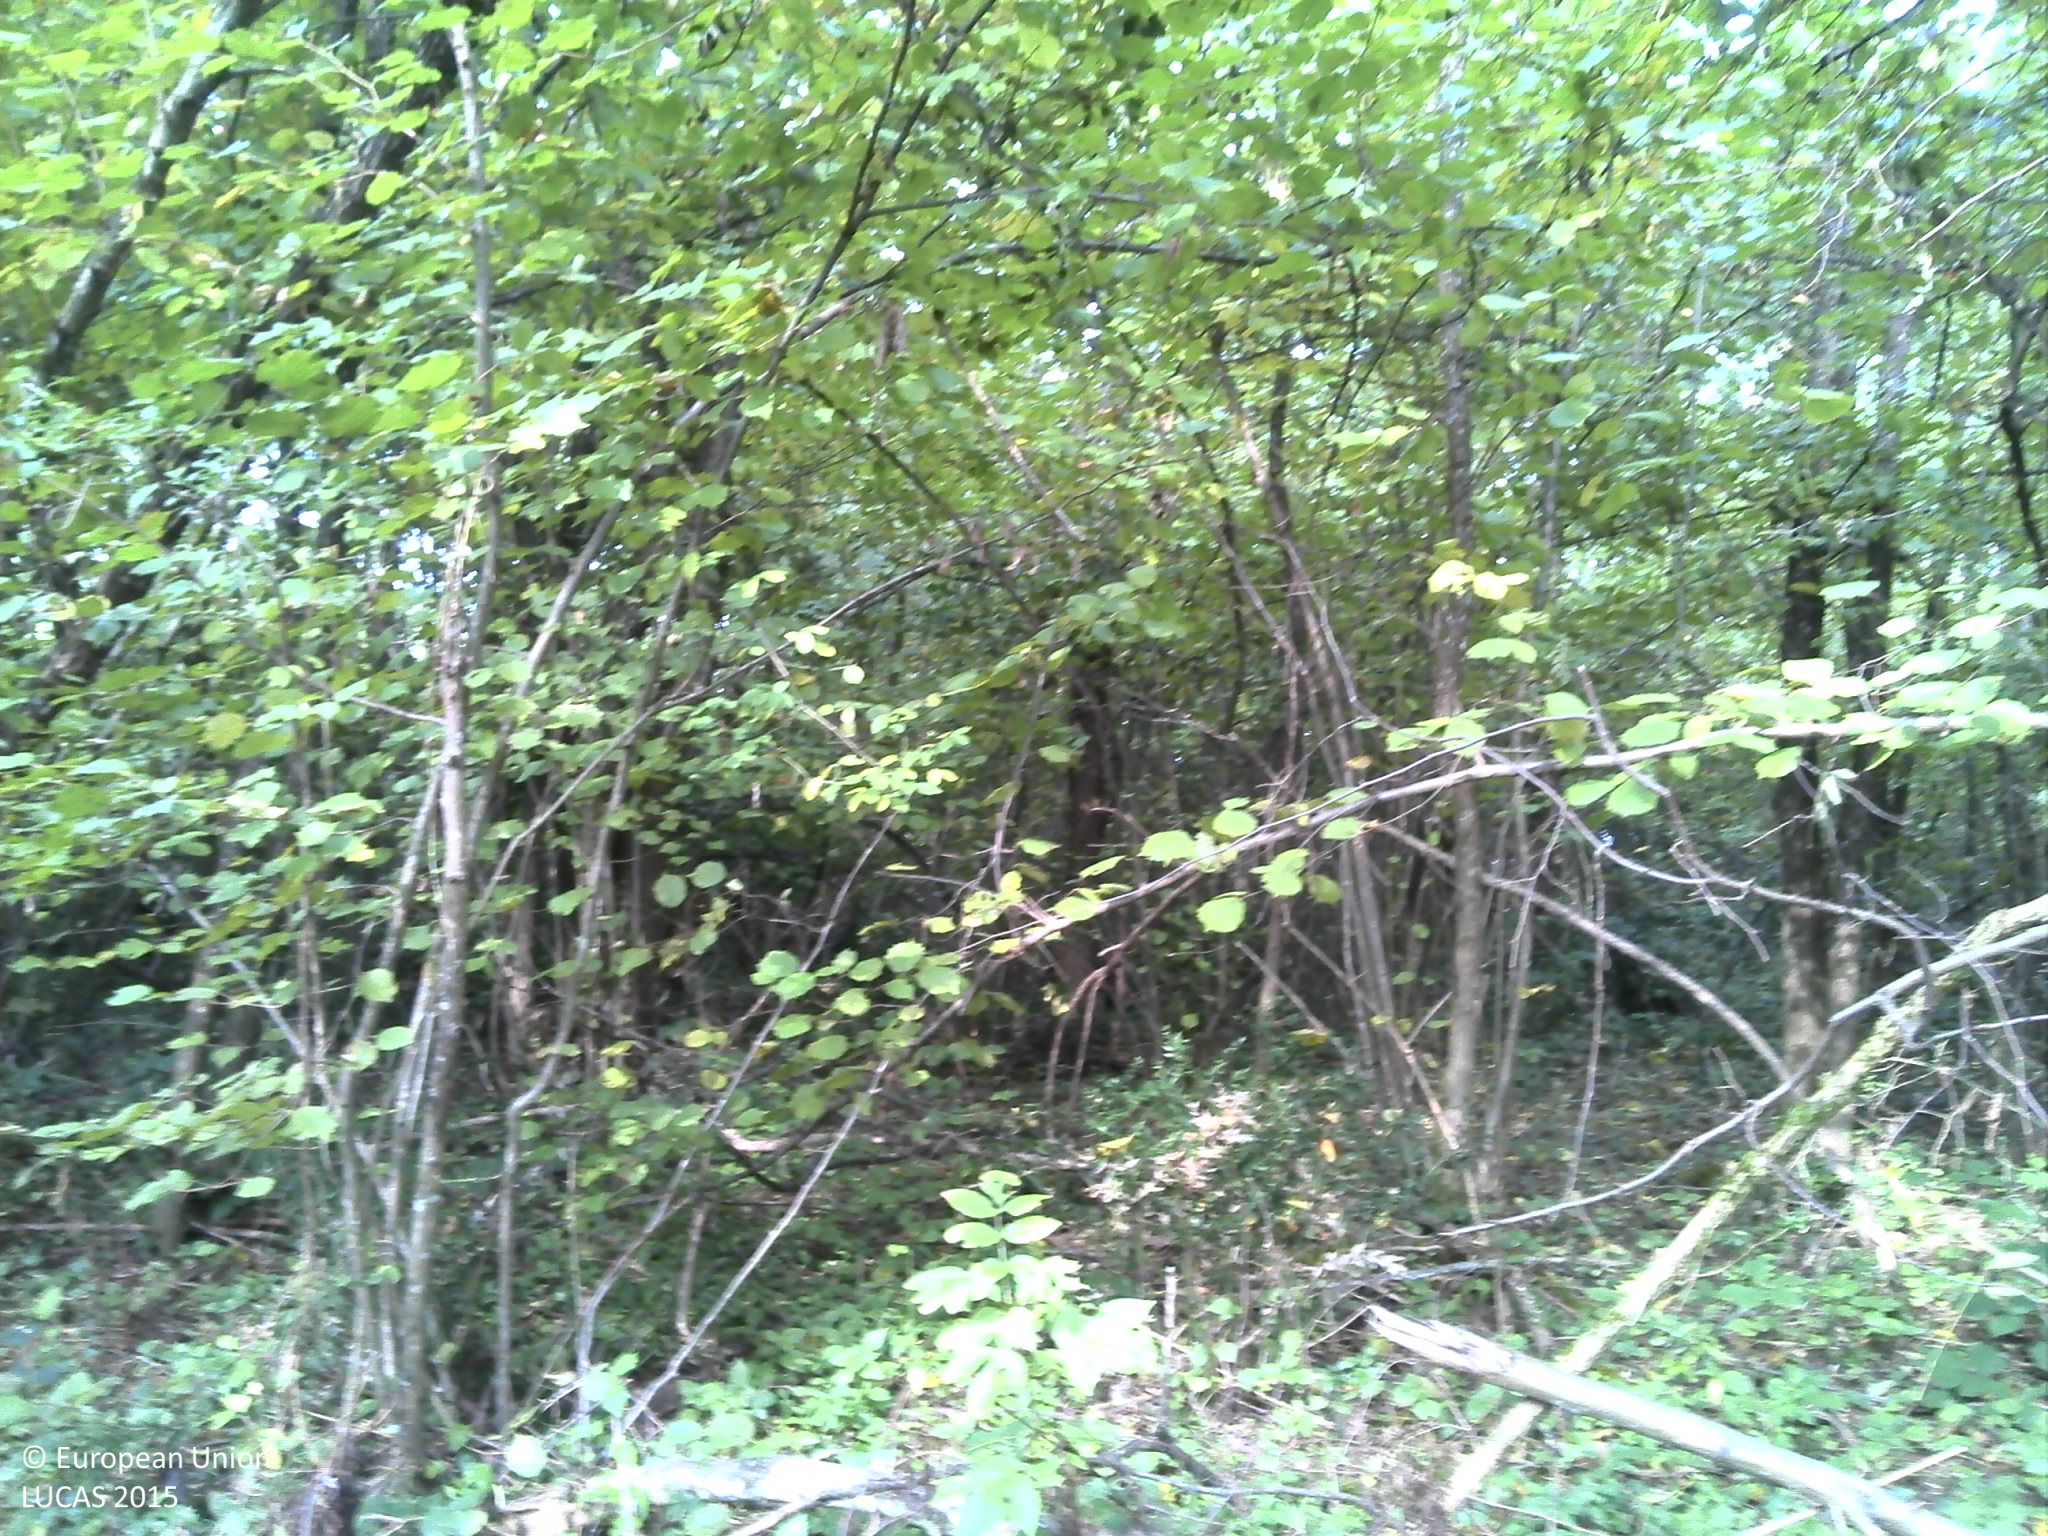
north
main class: Woodland
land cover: Broadleaved woodland
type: mesophytic deciduous forest
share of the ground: > 75 %
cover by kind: broadleaved forest trees 90 %, herbaceous plants 5 %, unconsolidated bare surface 5 %
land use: Forestry
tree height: > 5 m
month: October
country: FR
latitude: 45.9433
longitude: 5.3470
